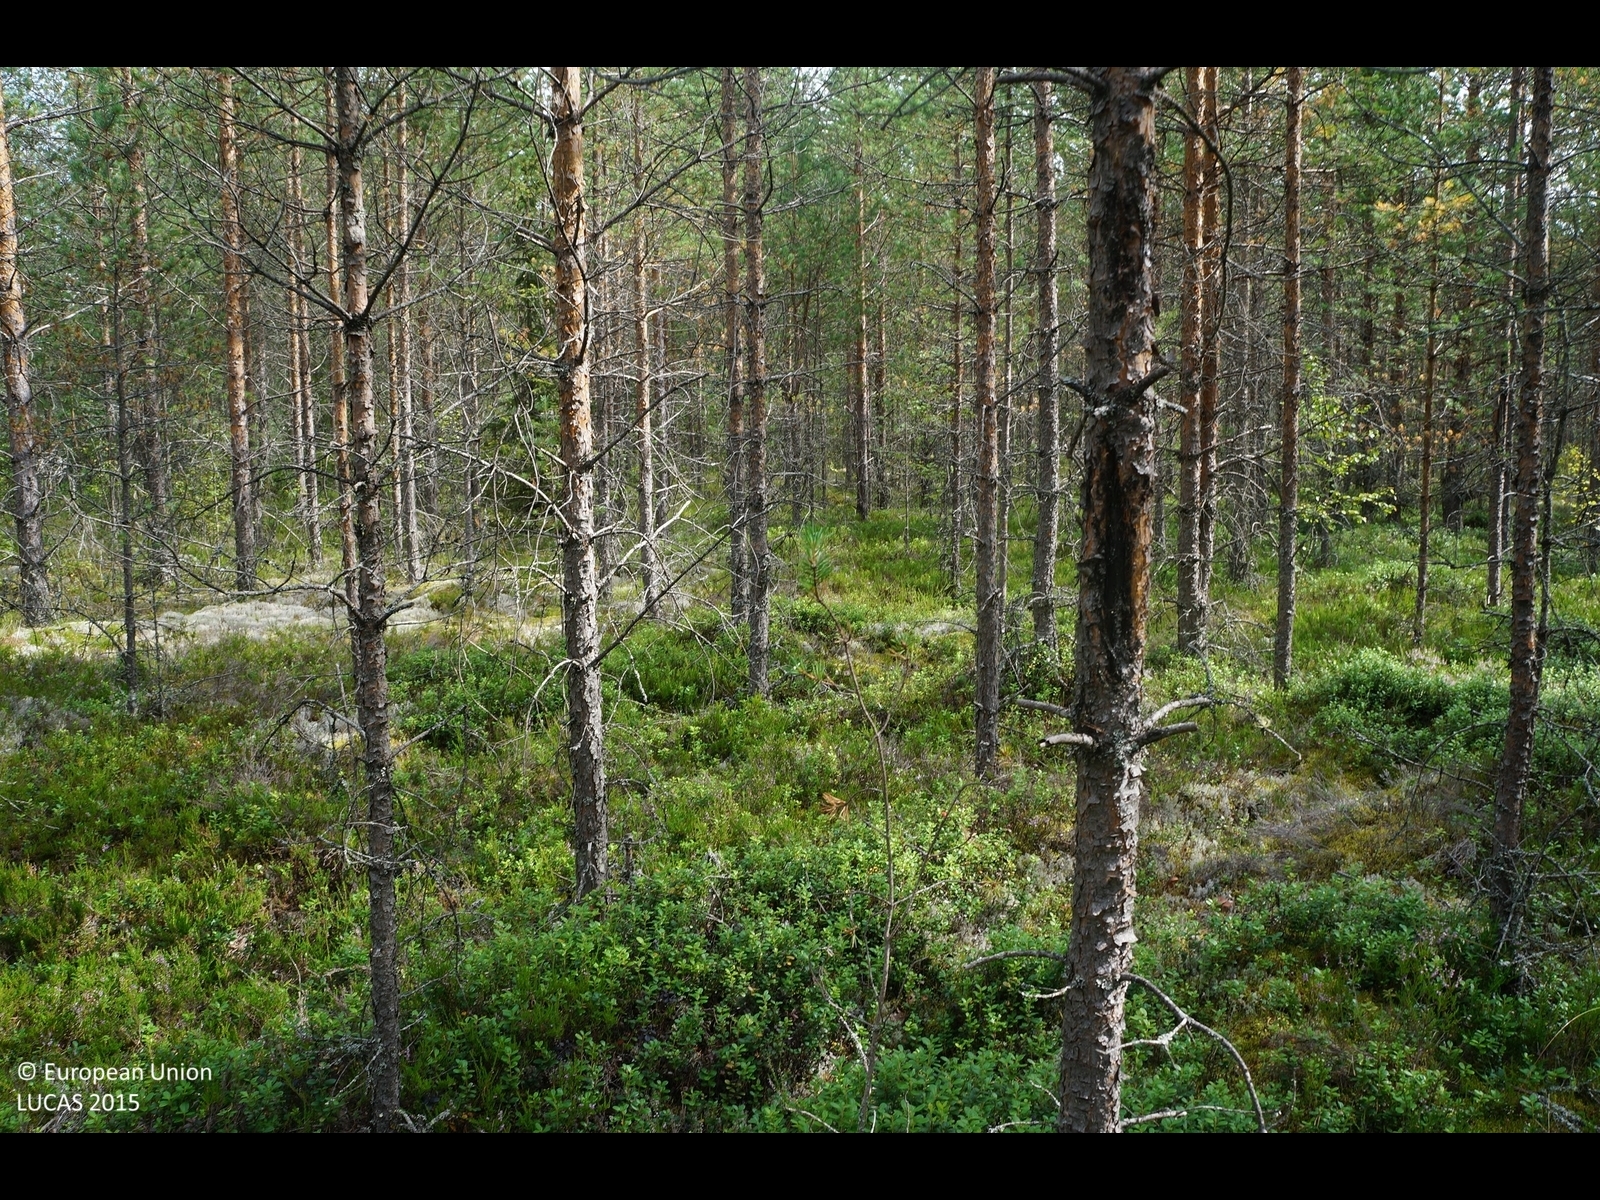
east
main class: Woodland
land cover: Pine dominated coniferous woodland
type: boreal forest
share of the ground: 50 - 75 %
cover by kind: coniferous forest trees 60 %, shrubs 20 %, lichens and mosses 20 %
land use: Forestry
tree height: > 5 m
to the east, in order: Pine dominated coniferous woodland; Pine dominated mixed woodland; Ditches and canals; Pine dominated mixed woodland; Ditches and canals; Pine dominated coniferous woodland; Pine dominated mixed woodland; Ditches and canals; Pine dominated mixed woodland; Pine dominated coniferous woodland; Ditches and canals; Pine dominated mixed woodland
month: August
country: FI
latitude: 64.7932
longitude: 24.7382
